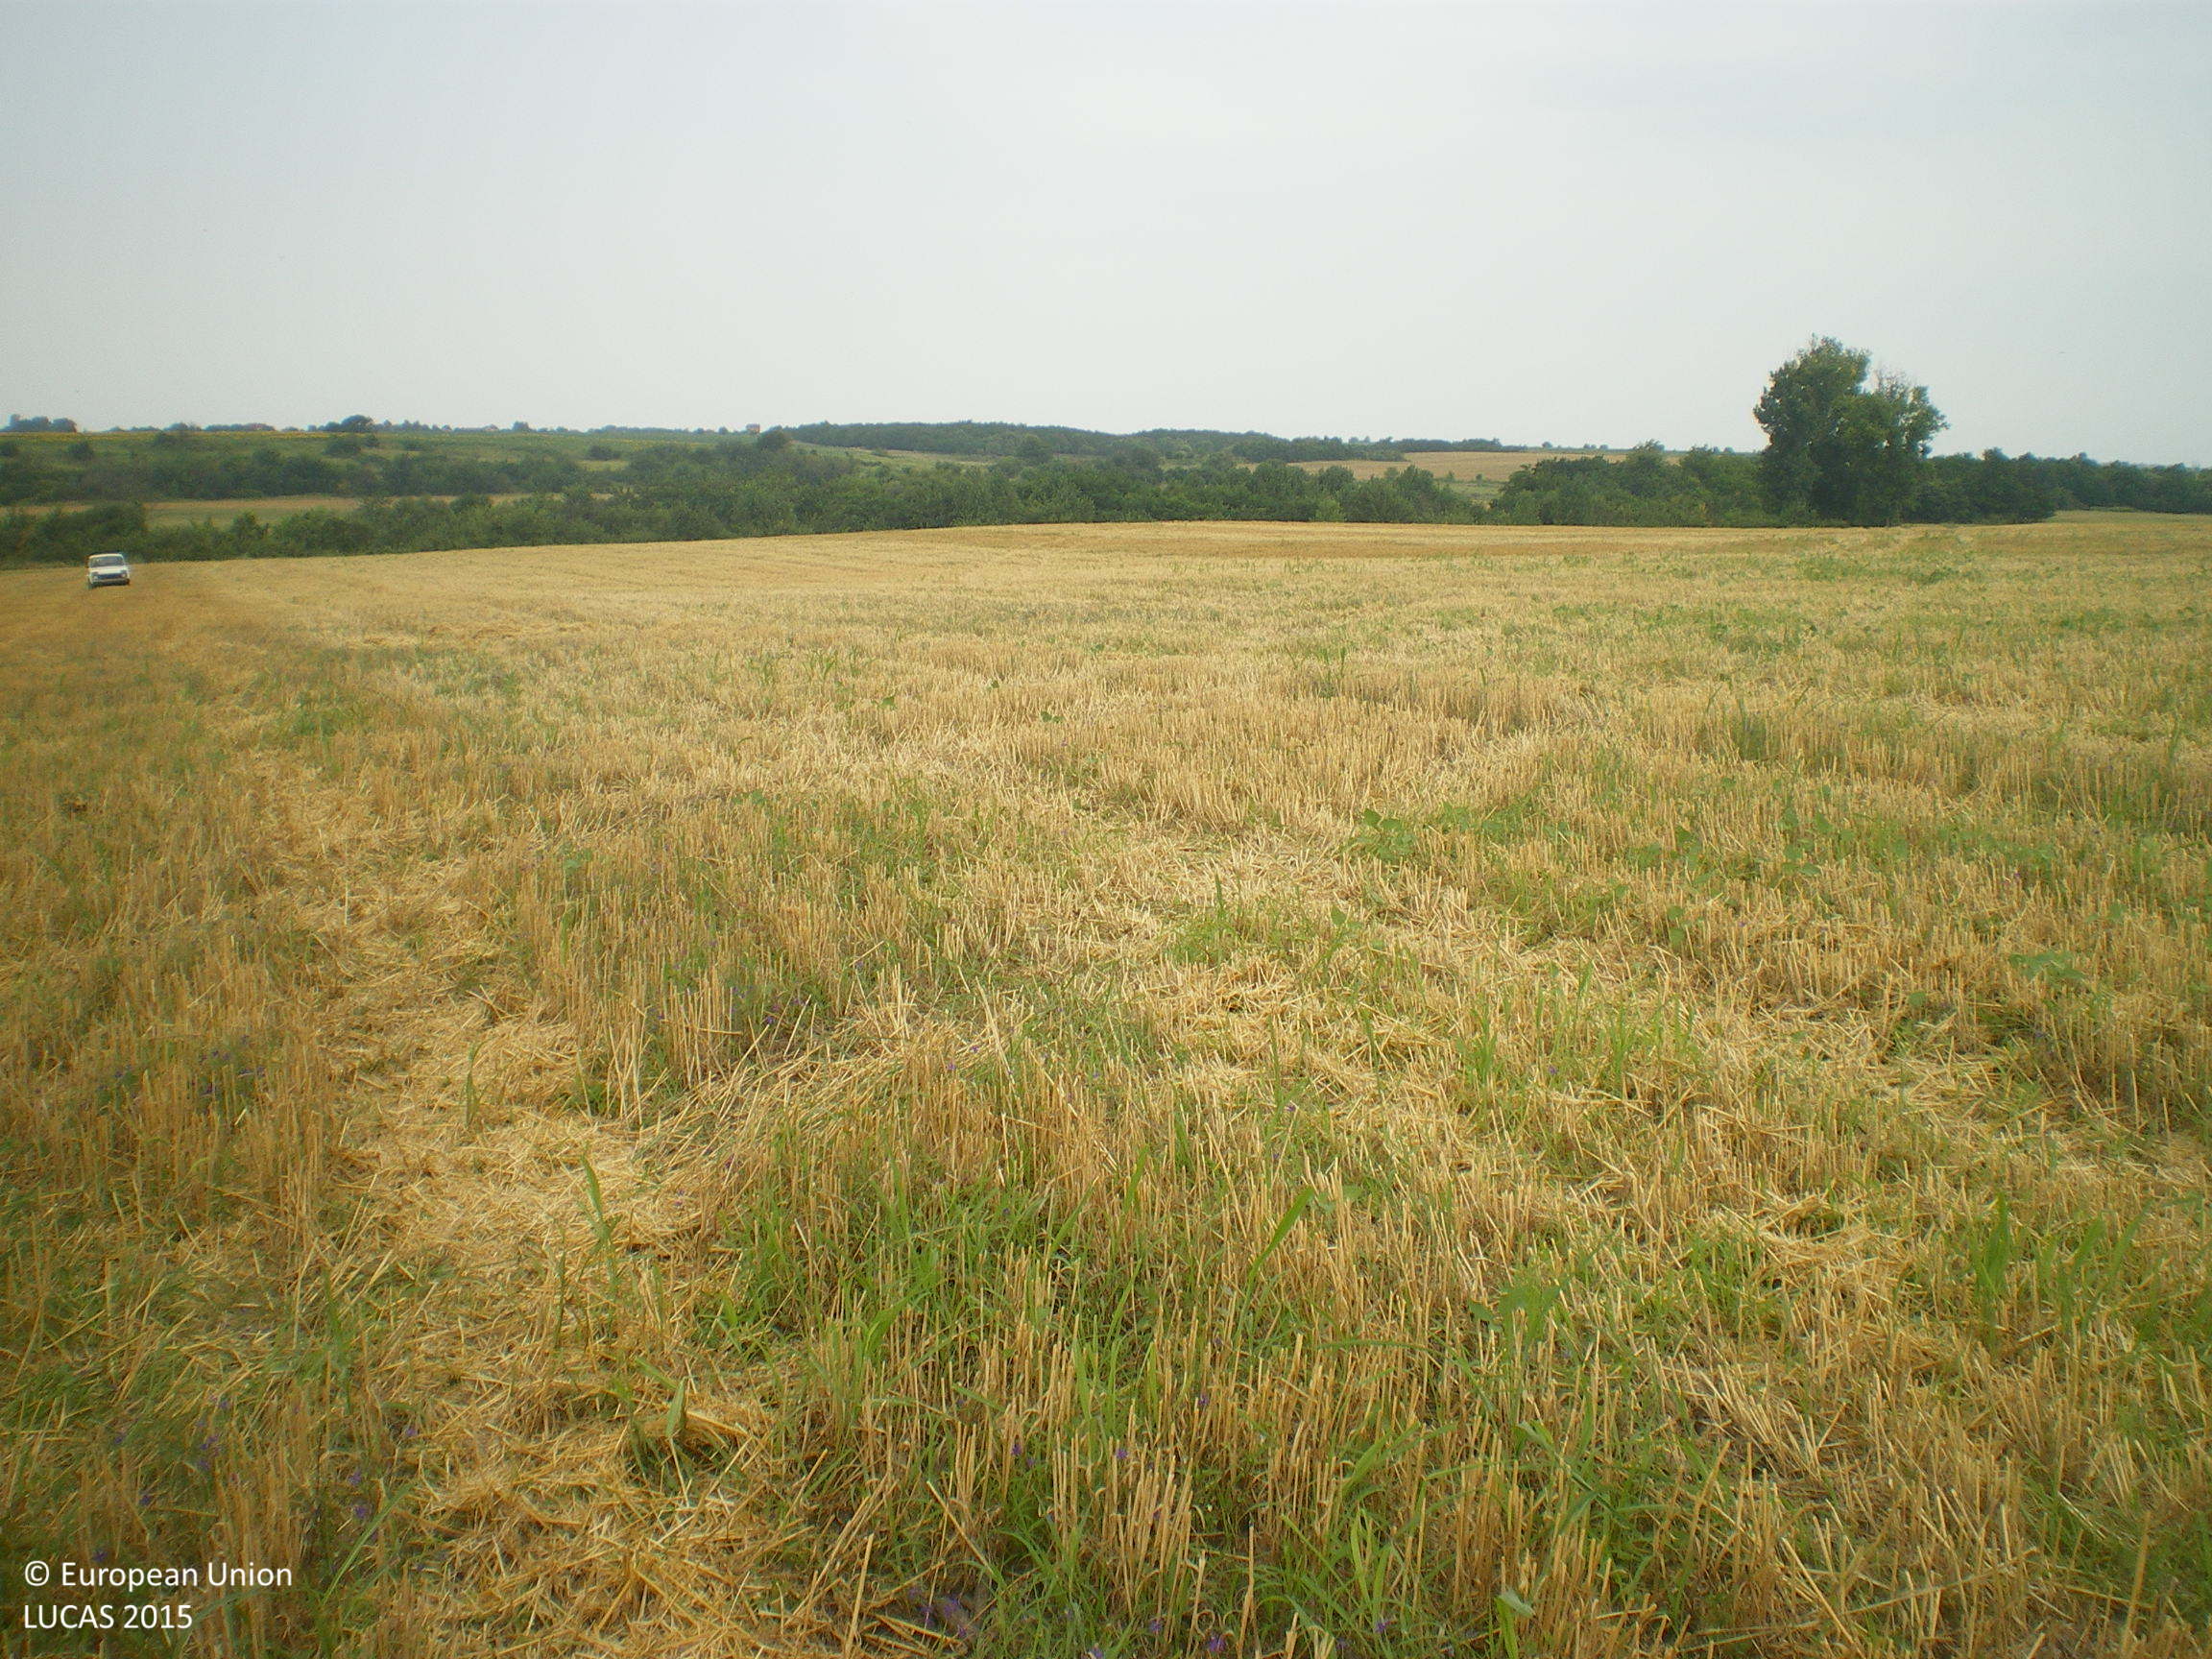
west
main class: Cropland
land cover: Common wheat
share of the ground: 25 - 50 %
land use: Agriculture (excluding fallow land and kitchen gardens)
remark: Harvested field
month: July
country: BG
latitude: 42.3187
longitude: 25.1181
